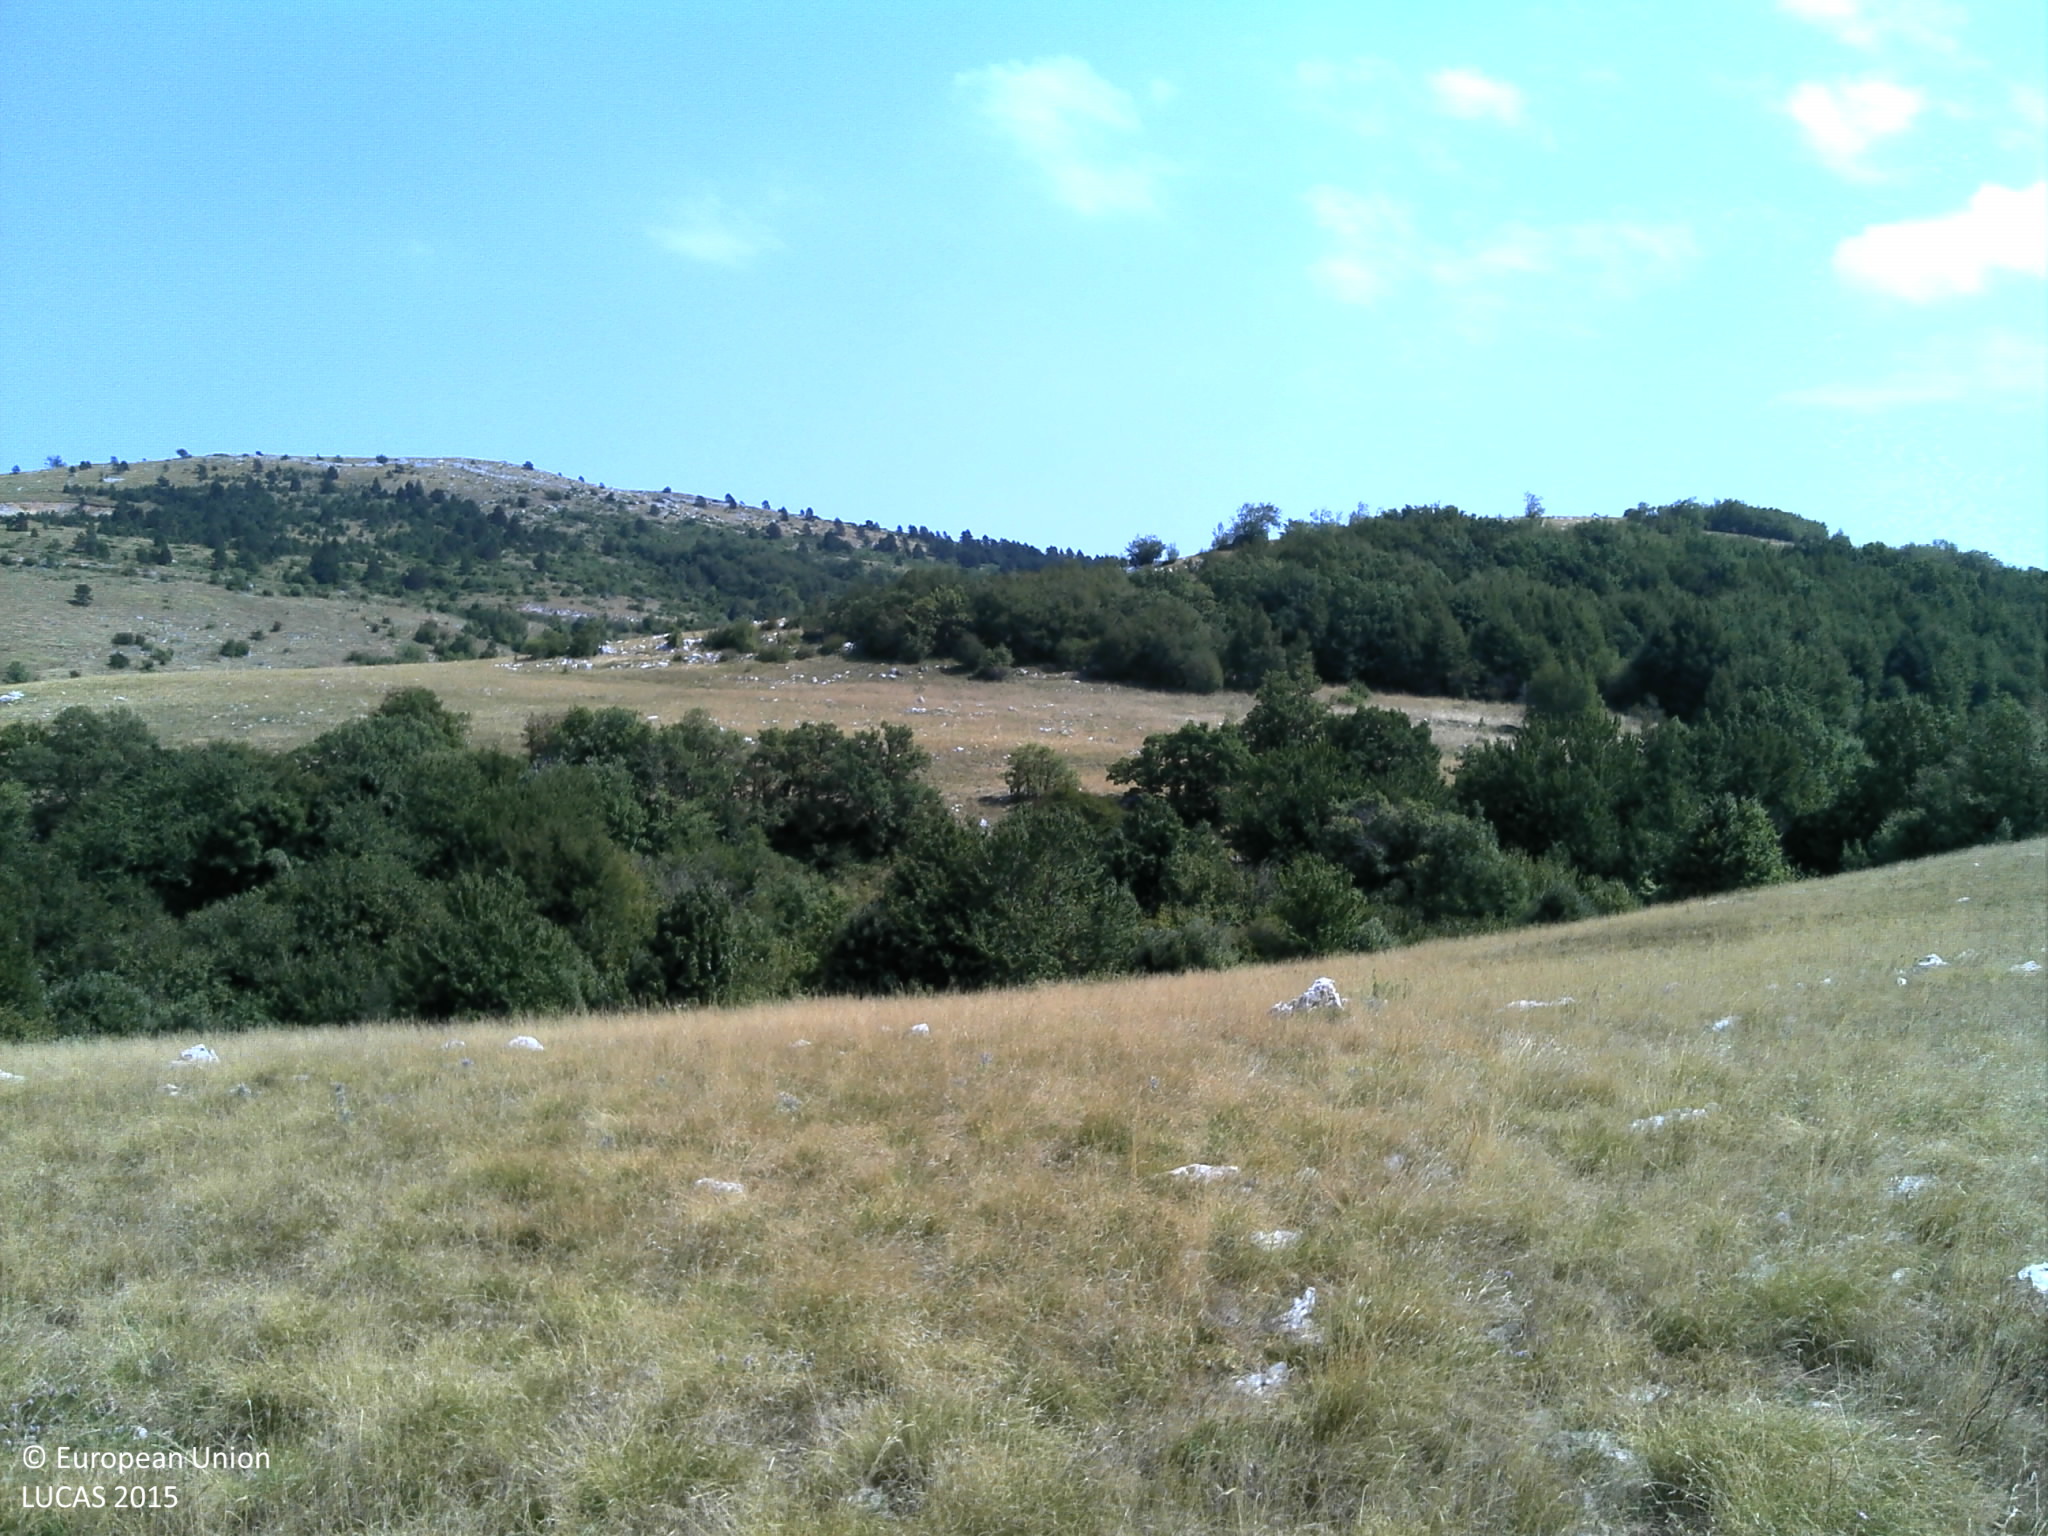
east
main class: Grassland
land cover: Grassland without tree/shrub cover
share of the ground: > 75 %
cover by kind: herbaceous plants 90 %, consolidated bare surface 5 %, unconsolidated bare surface 5 %
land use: Semi-natural and natural areas not in use
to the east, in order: Grassland without tree/shrub cover; Broadleaved woodland; Grassland without tree/shrub cover; Shrubland with sparse tree cover
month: August
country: HR
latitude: 45.0281
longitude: 14.9316
